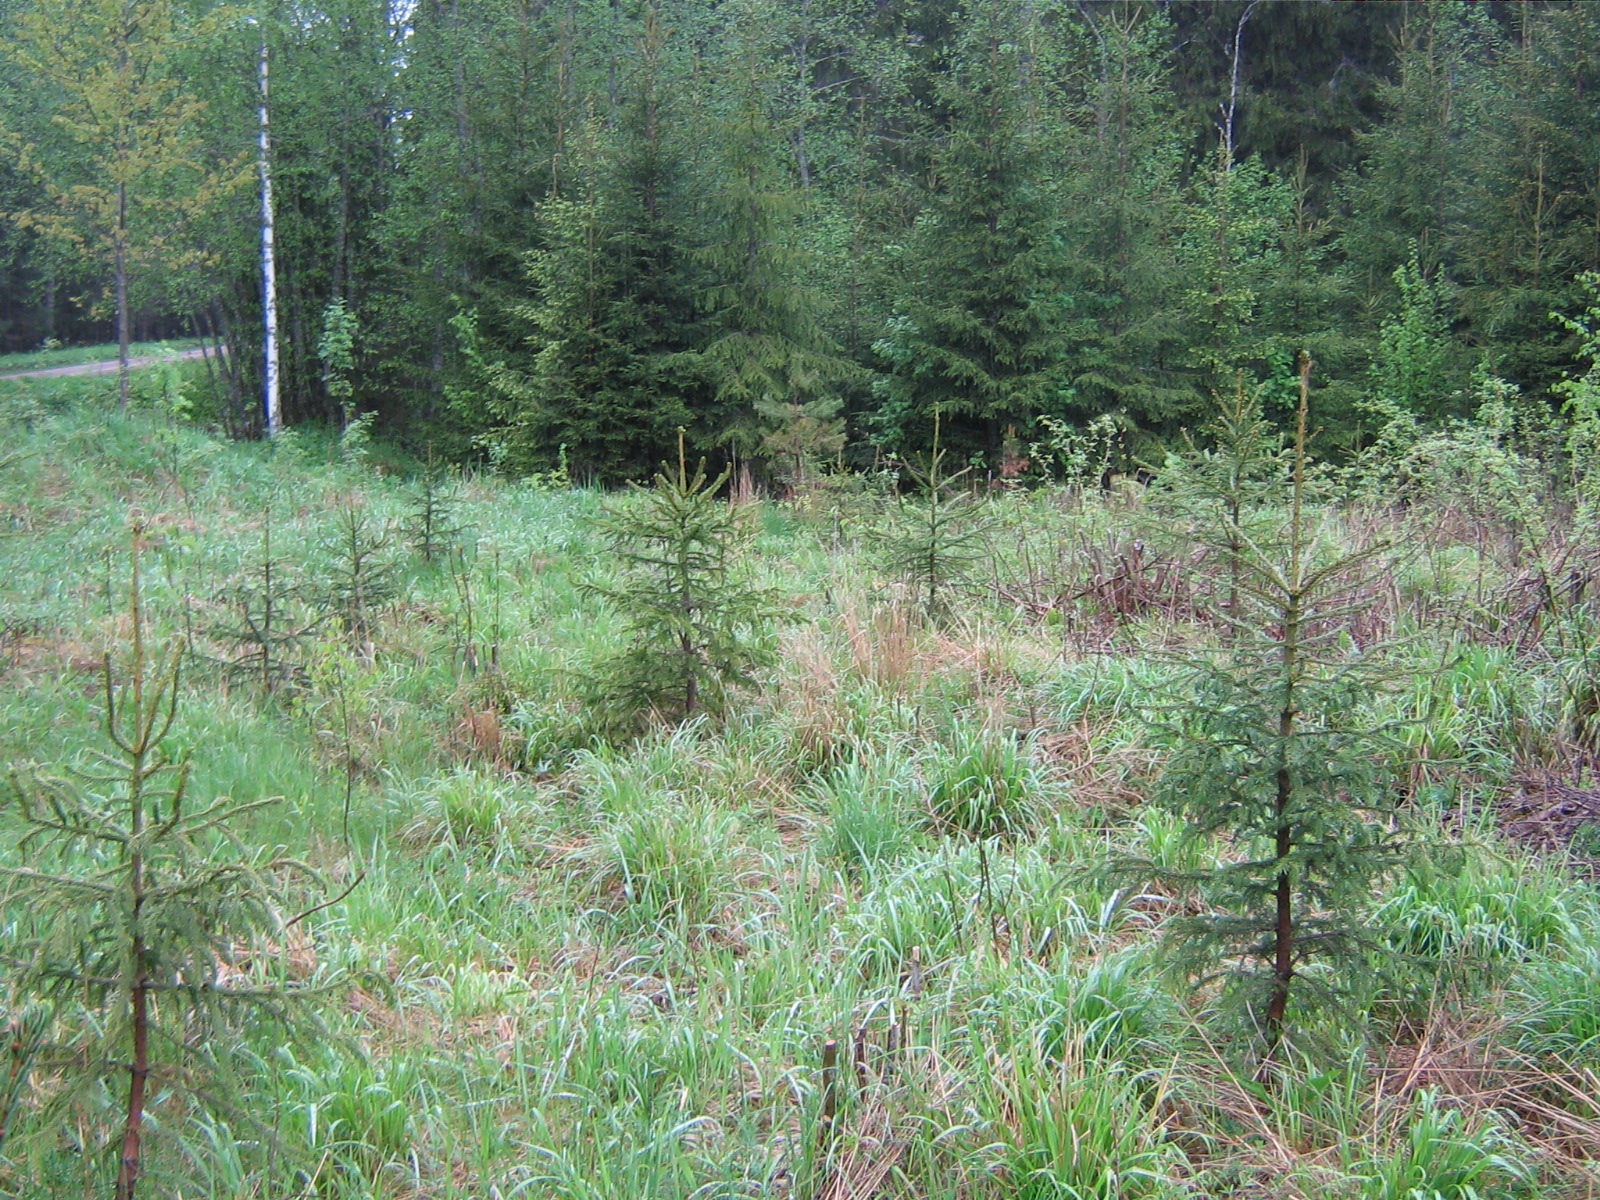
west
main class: Woodland
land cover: Spruce dominated mixed woodland
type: hemiboreal forest and nemoral coniferous forest and mixed broadleaved-coniferous forest
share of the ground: 25 - 50 %
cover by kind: herbaceous plants 60 %, coniferous forest trees 25 %, broadleaved forest trees 15 %
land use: Forestry
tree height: < 5 m
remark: Clear cut
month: May
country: LV
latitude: 57.3126
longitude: 25.9499
